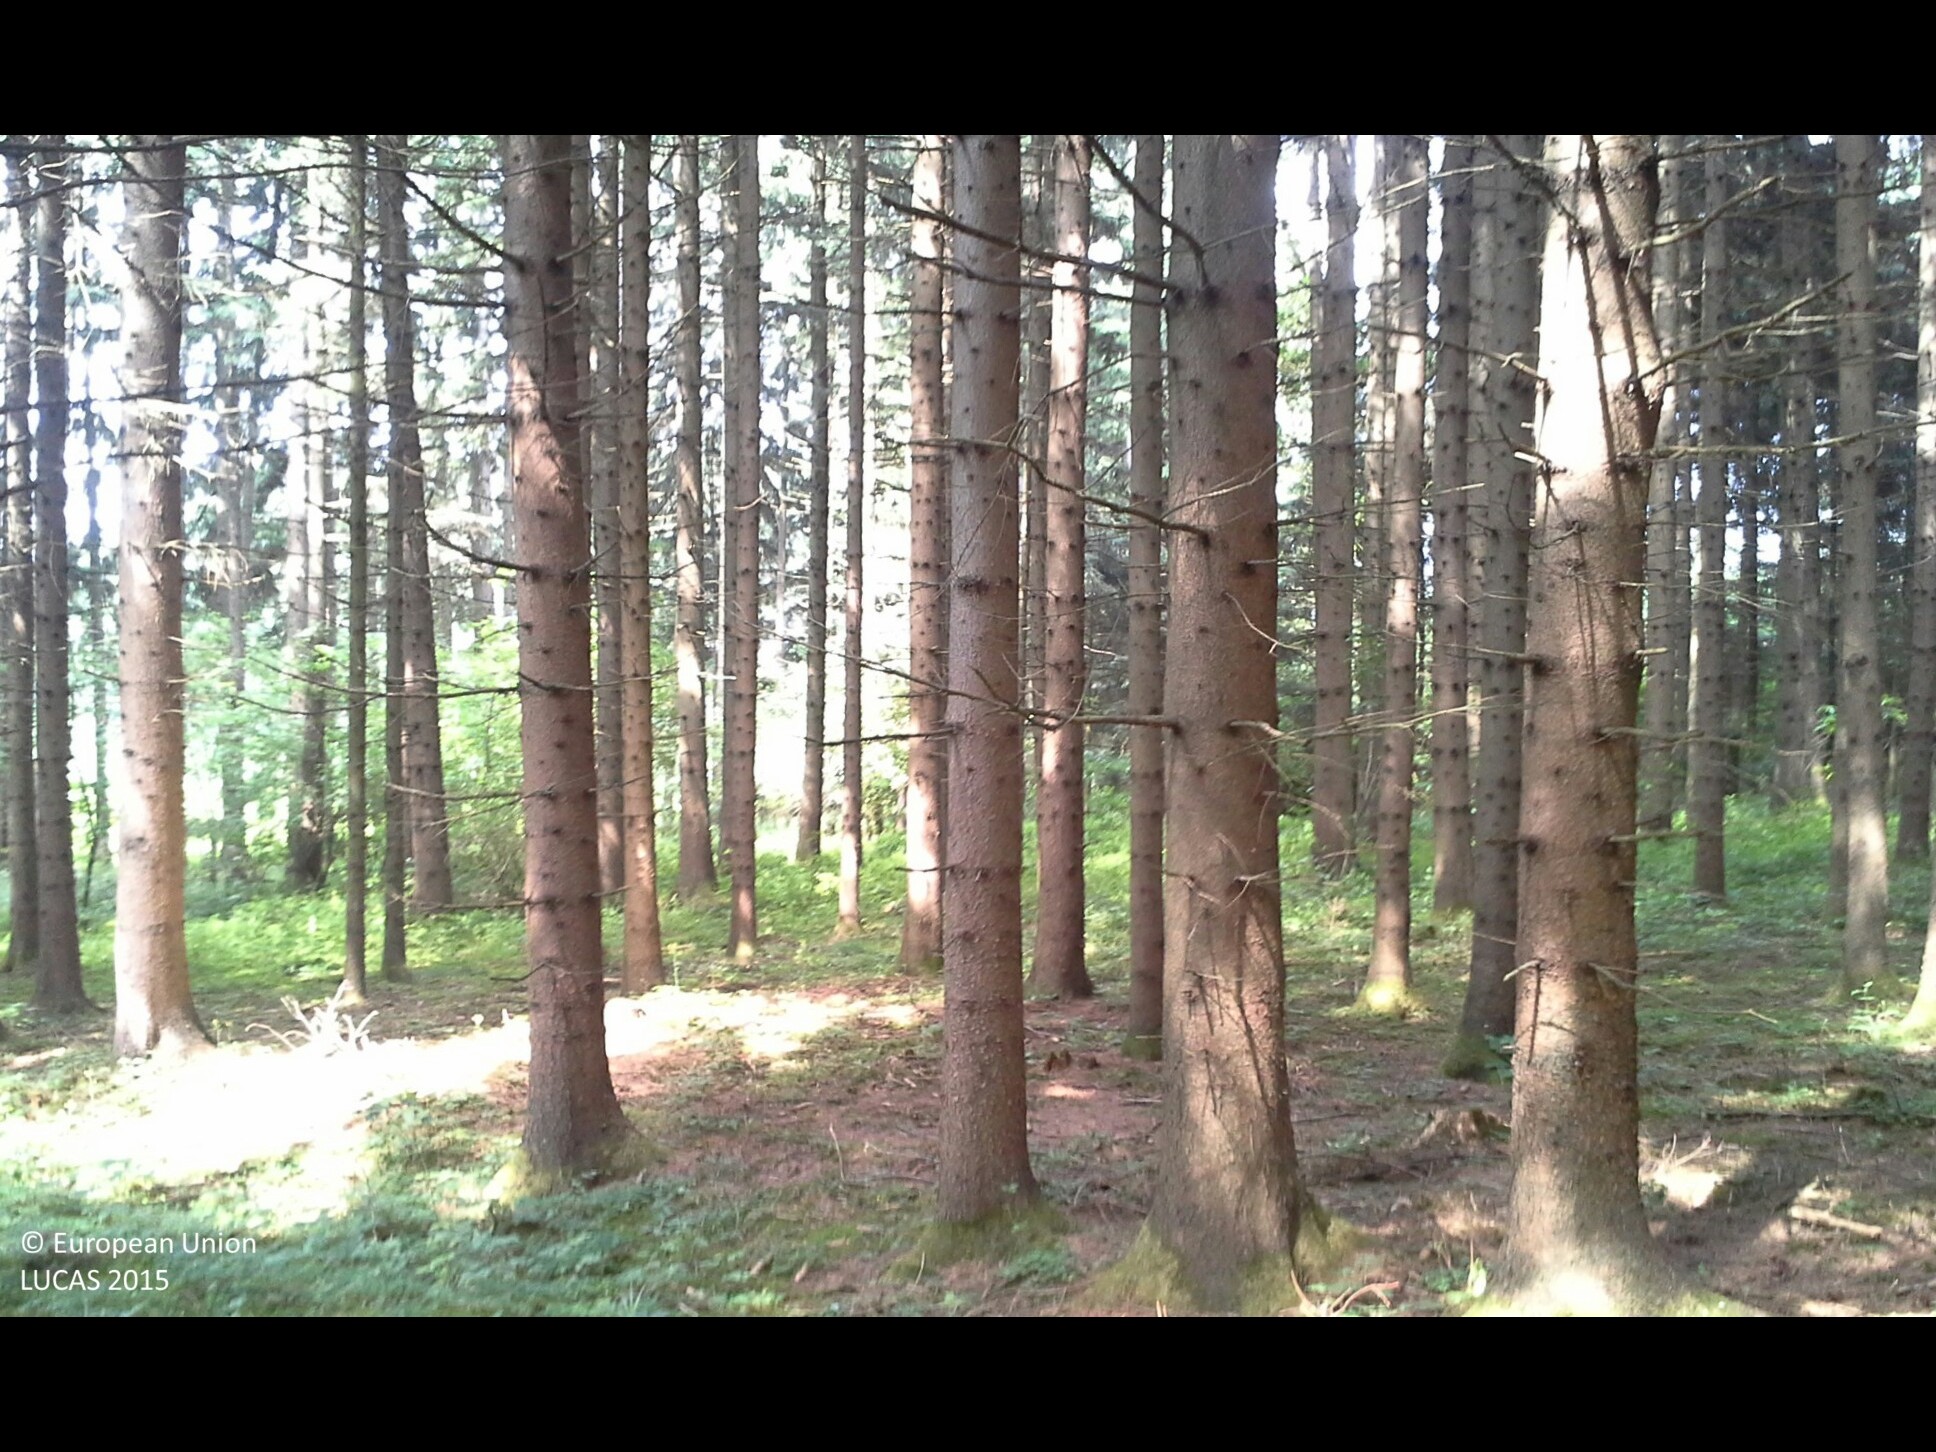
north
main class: Woodland
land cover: Spruce dominated coniferous woodland
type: hemiboreal forest and nemoral coniferous forest and mixed broadleaved-coniferous forest
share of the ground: > 75 %
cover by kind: coniferous forest trees 100 %
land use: Forestry
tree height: > 5 m
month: June
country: AT
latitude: 48.0663
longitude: 14.3345
